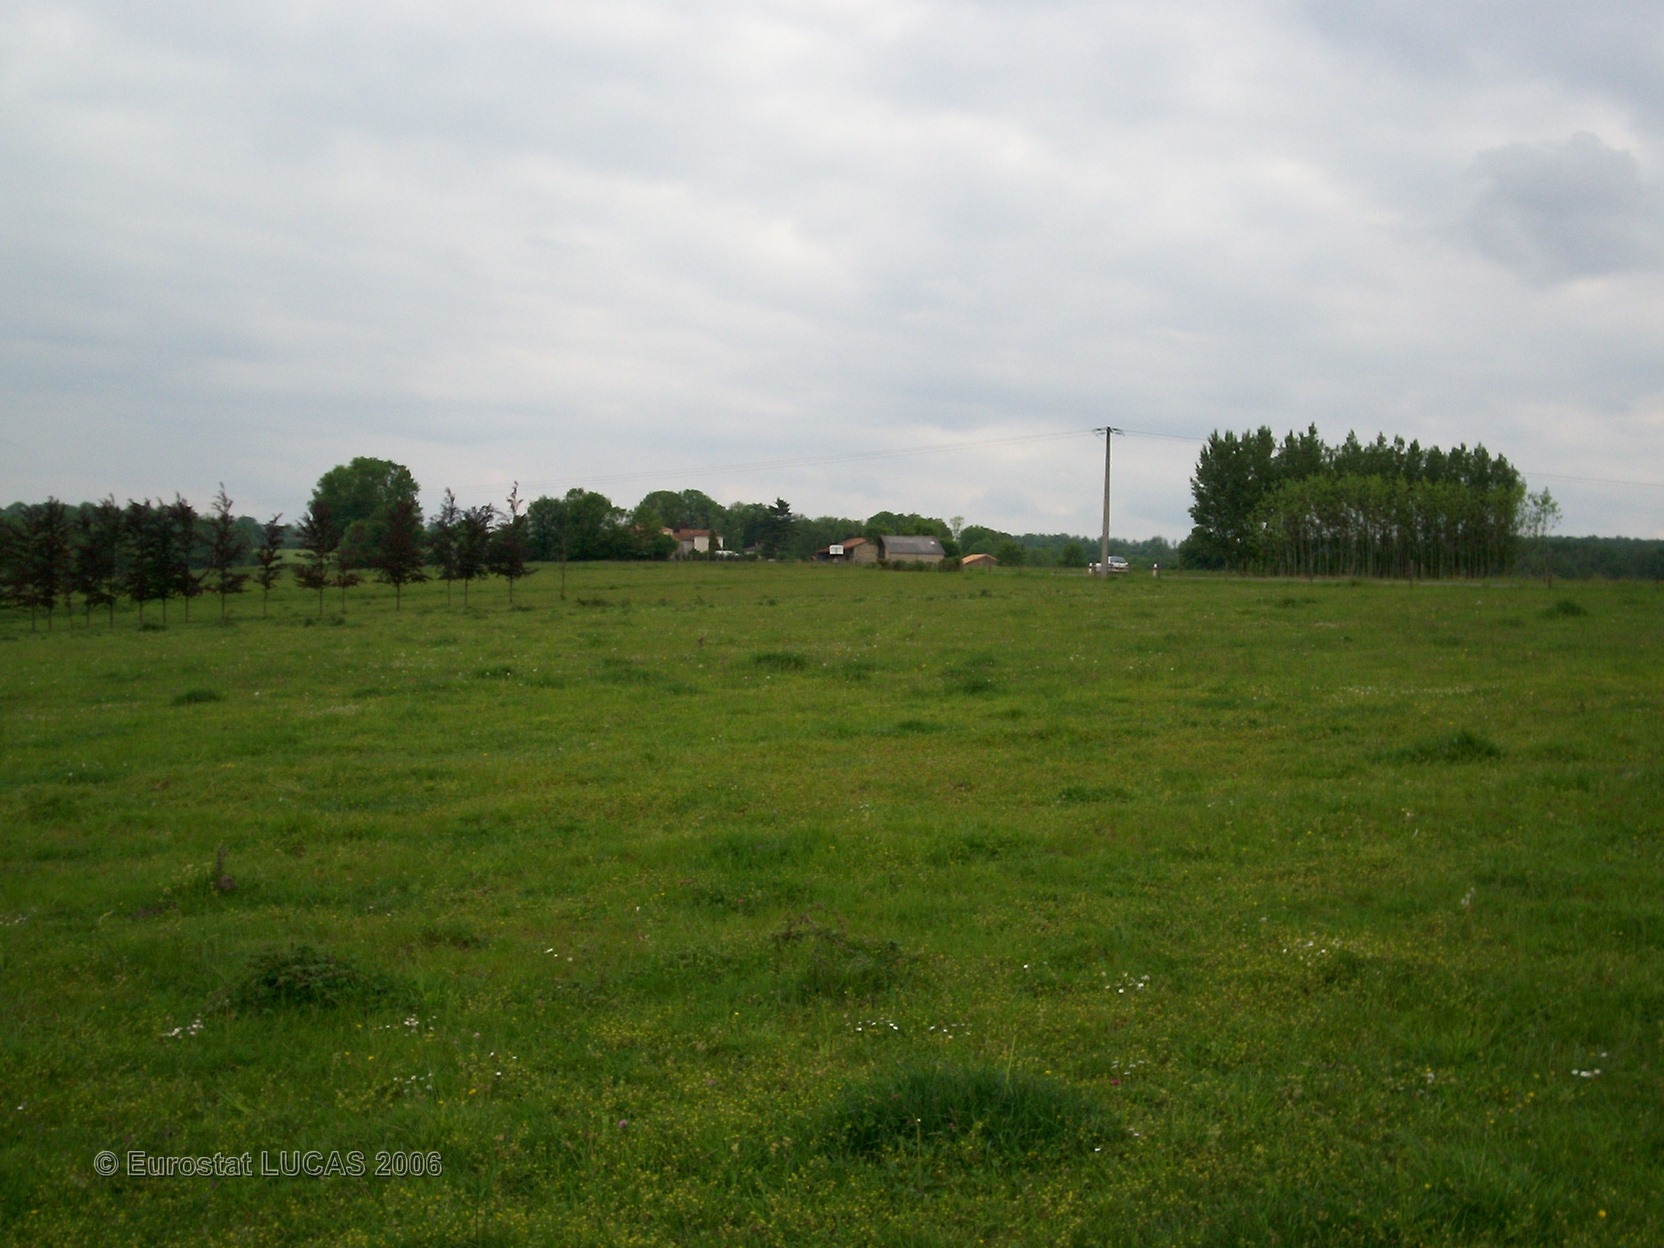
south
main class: Grassland
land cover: Grassland without tree/shrub cover
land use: Agriculture (excluding fallow land and kitchen gardens)
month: May
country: FR
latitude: 45.7697
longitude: 0.5604
